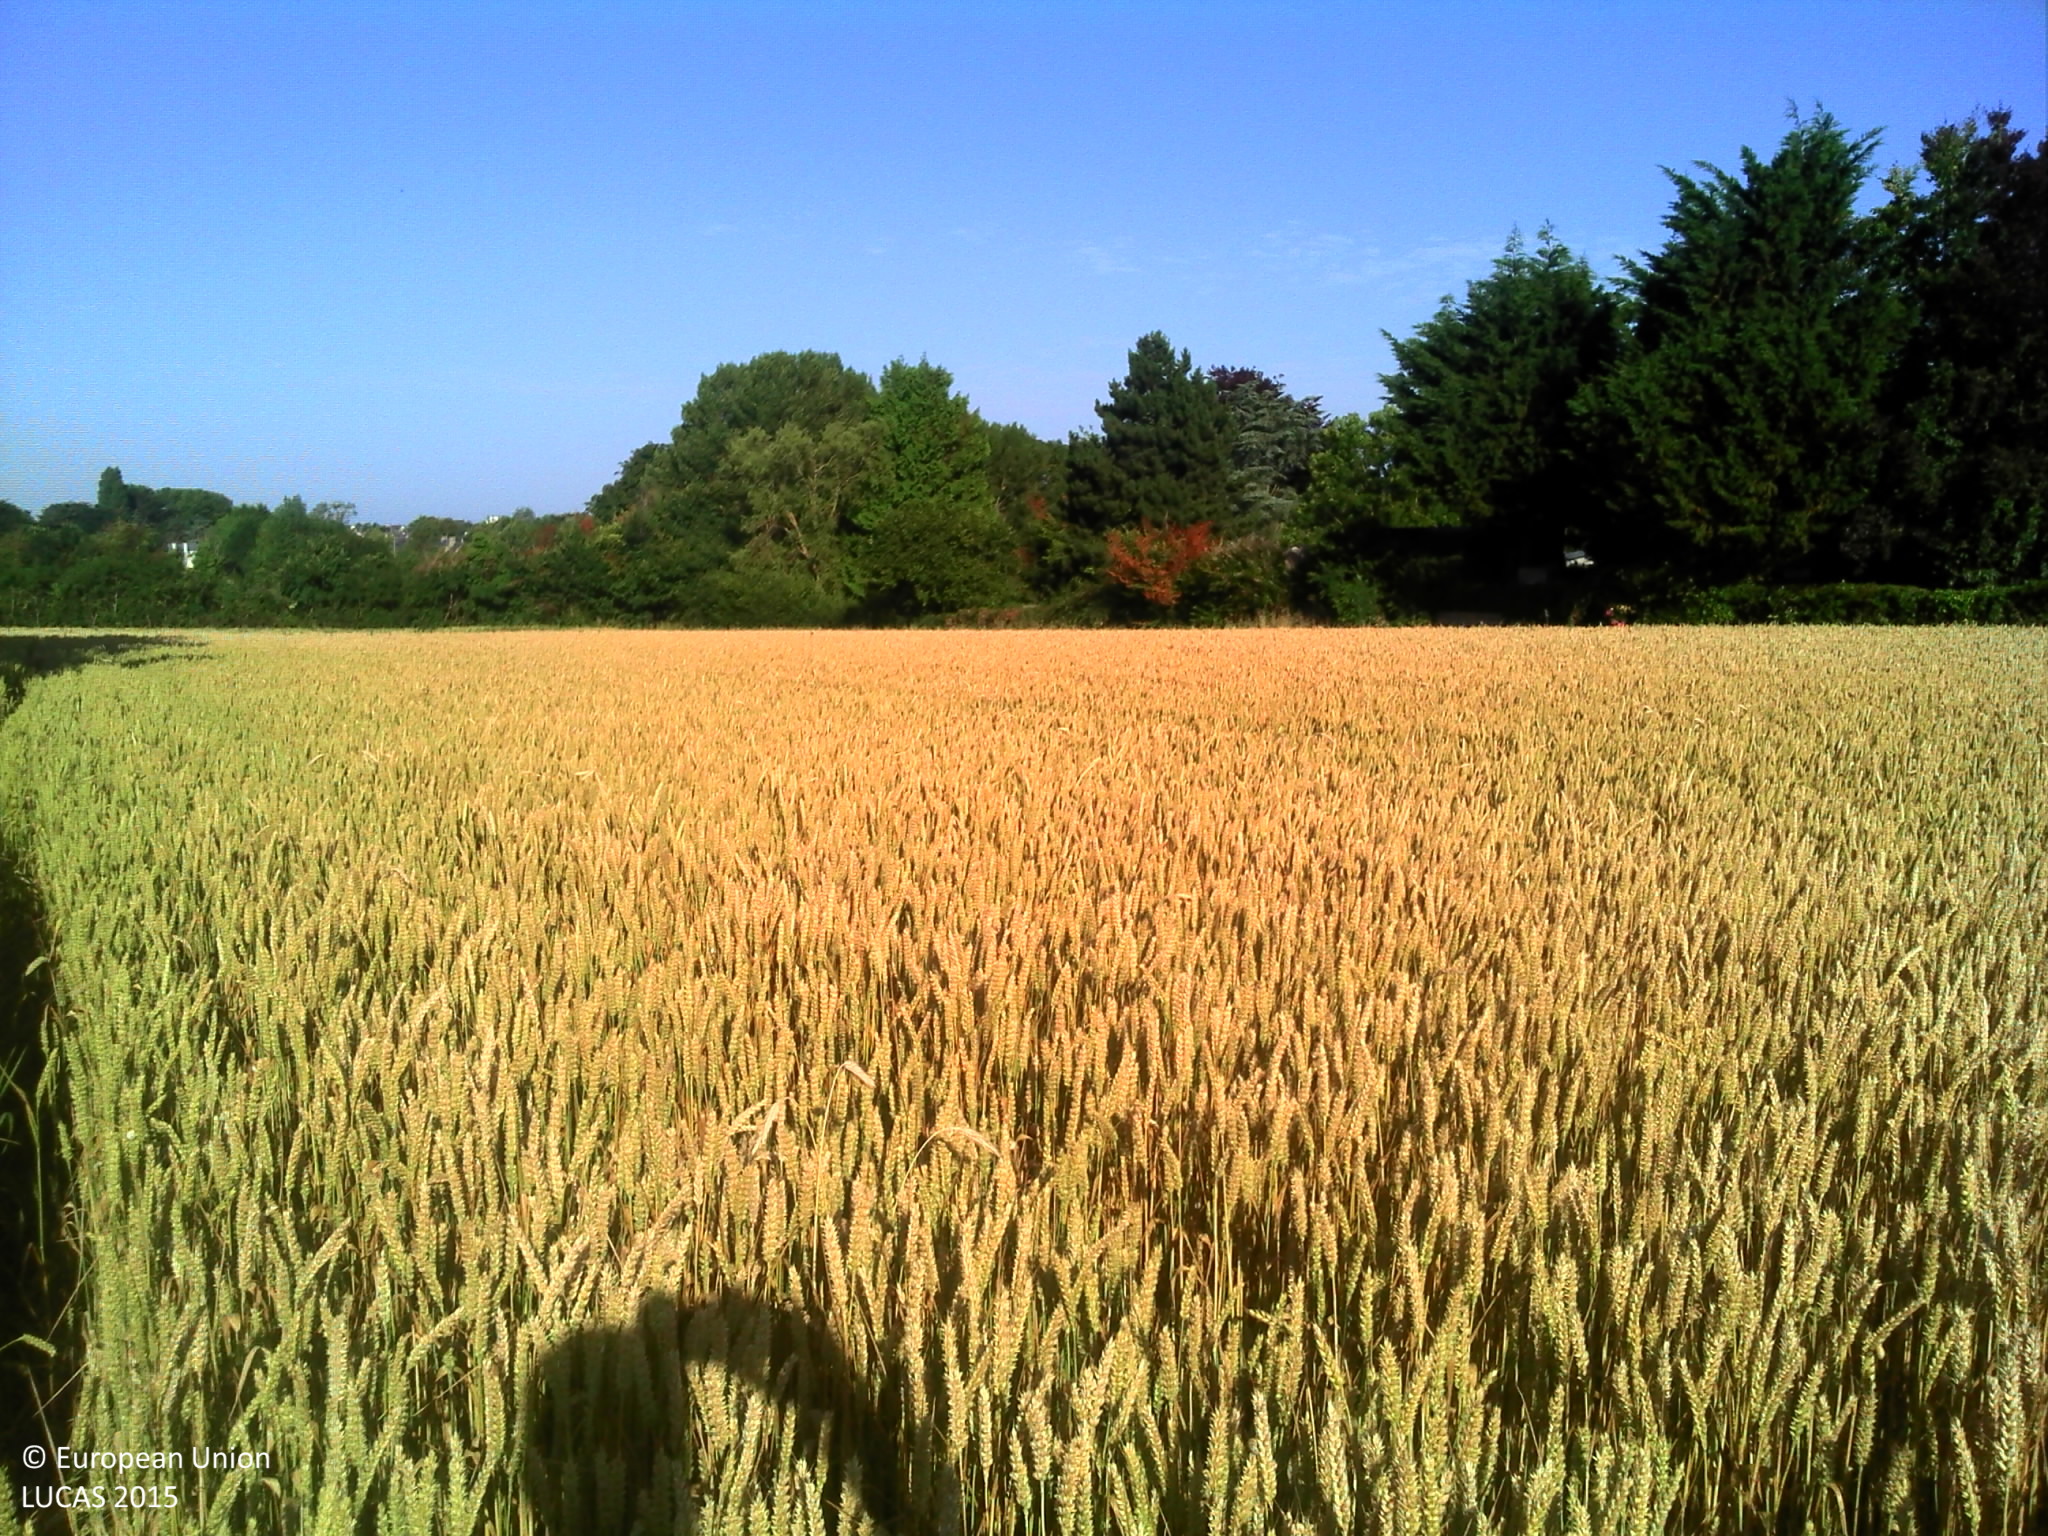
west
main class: Cropland
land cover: Common wheat
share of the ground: > 75 %
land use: Agriculture (excluding fallow land and kitchen gardens)
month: July
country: FR
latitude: 49.0464
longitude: -1.5833
